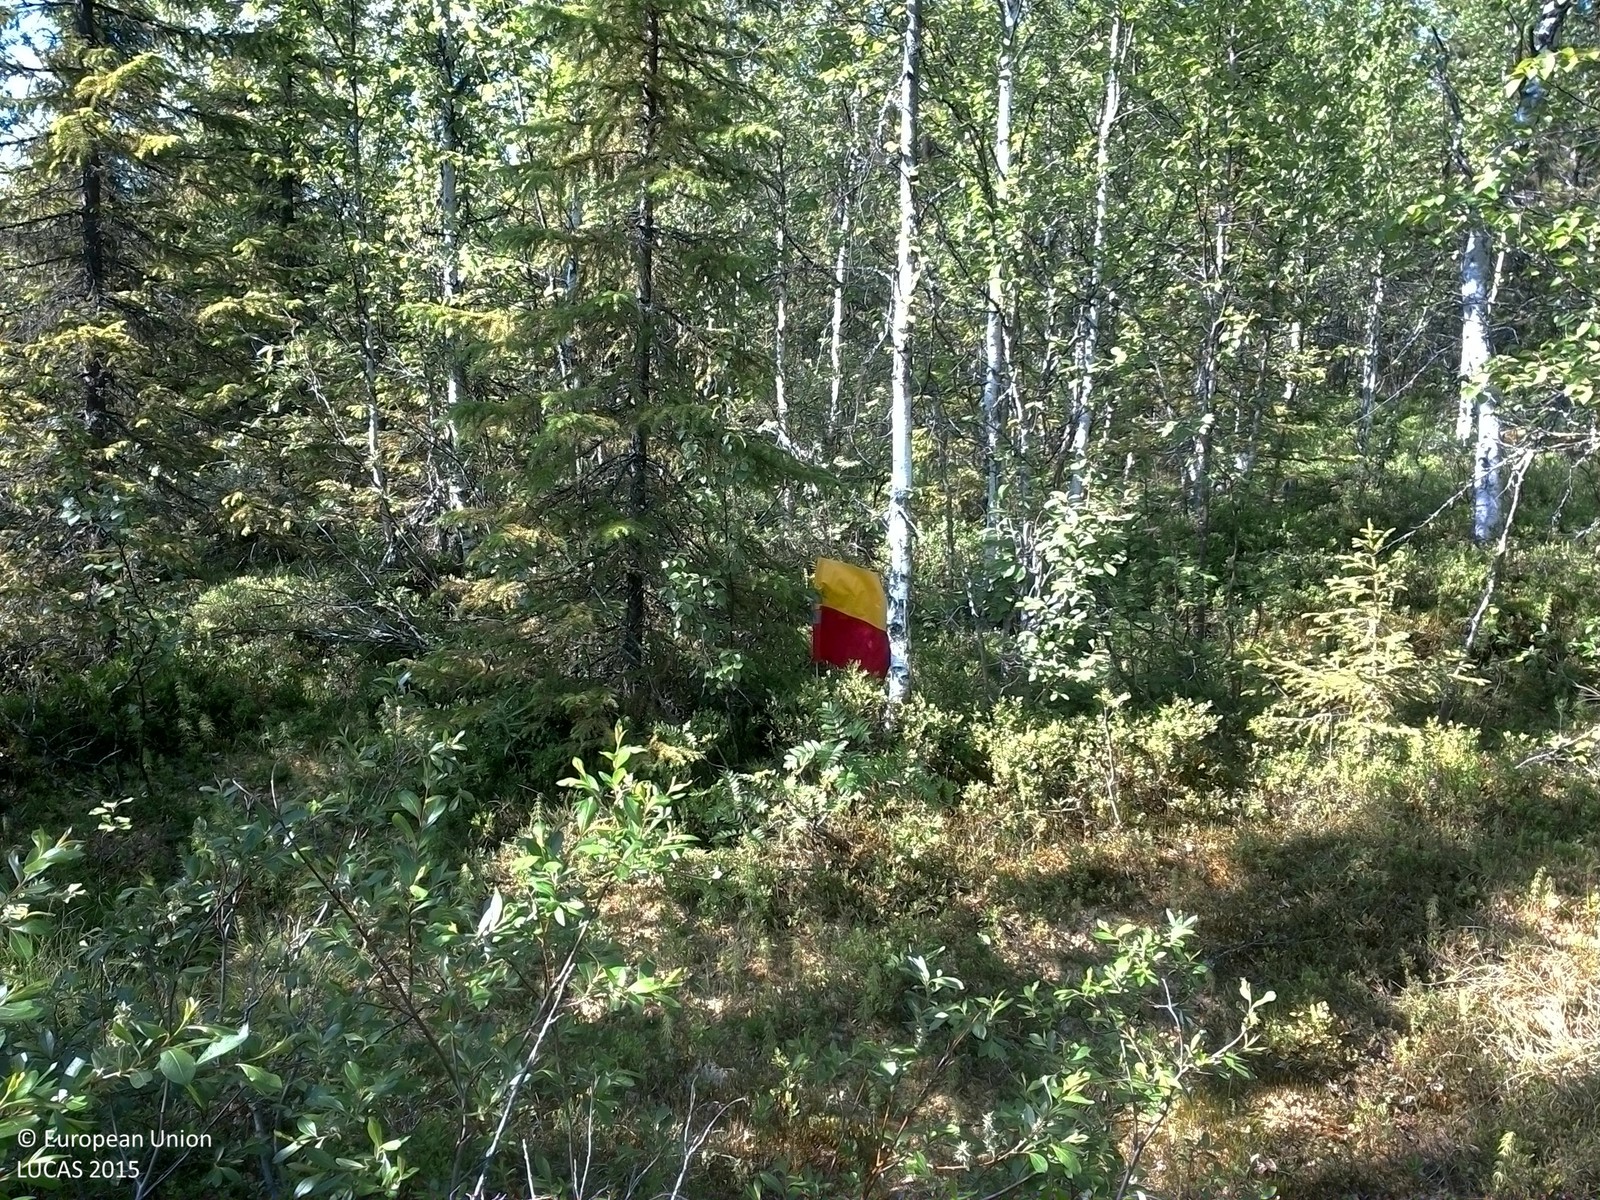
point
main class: Woodland
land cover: Spruce dominated mixed woodland
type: boreal forest
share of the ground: 50 - 75 %
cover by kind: coniferous forest trees 50 %, broadleaved forest trees 20 %, shrubs 15 %, lichens and mosses 10 %, herbaceous plants 5 %
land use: Forestry
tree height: < 5 m
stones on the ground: 10 - 25 %
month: July
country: SE
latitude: 64.3868
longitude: 16.6236
